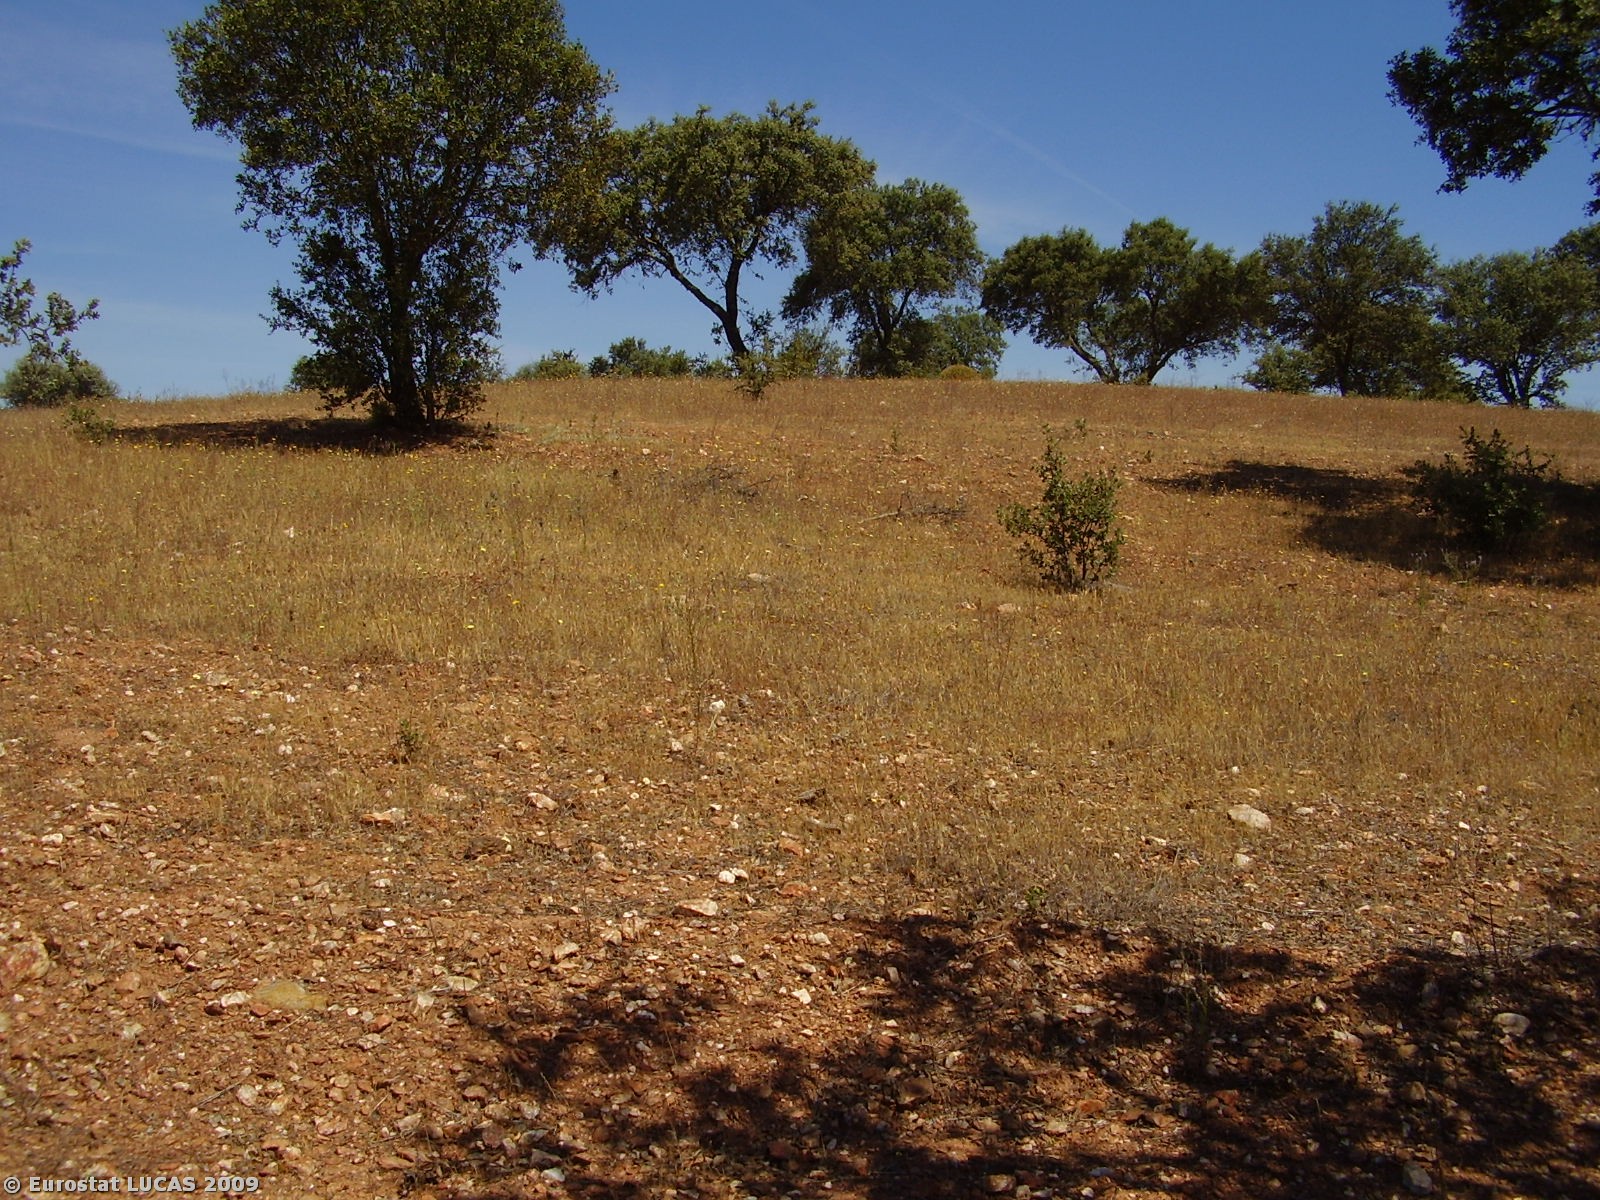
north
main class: Woodland
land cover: Broadleaved woodland
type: broadleaved evergreen forest
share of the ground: 10 - 25 %
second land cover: Bare land
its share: 25 - 50 %
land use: Forestry
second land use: Fallow land
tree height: > 5 m
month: May
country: PT
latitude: 37.7713
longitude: -7.7185
